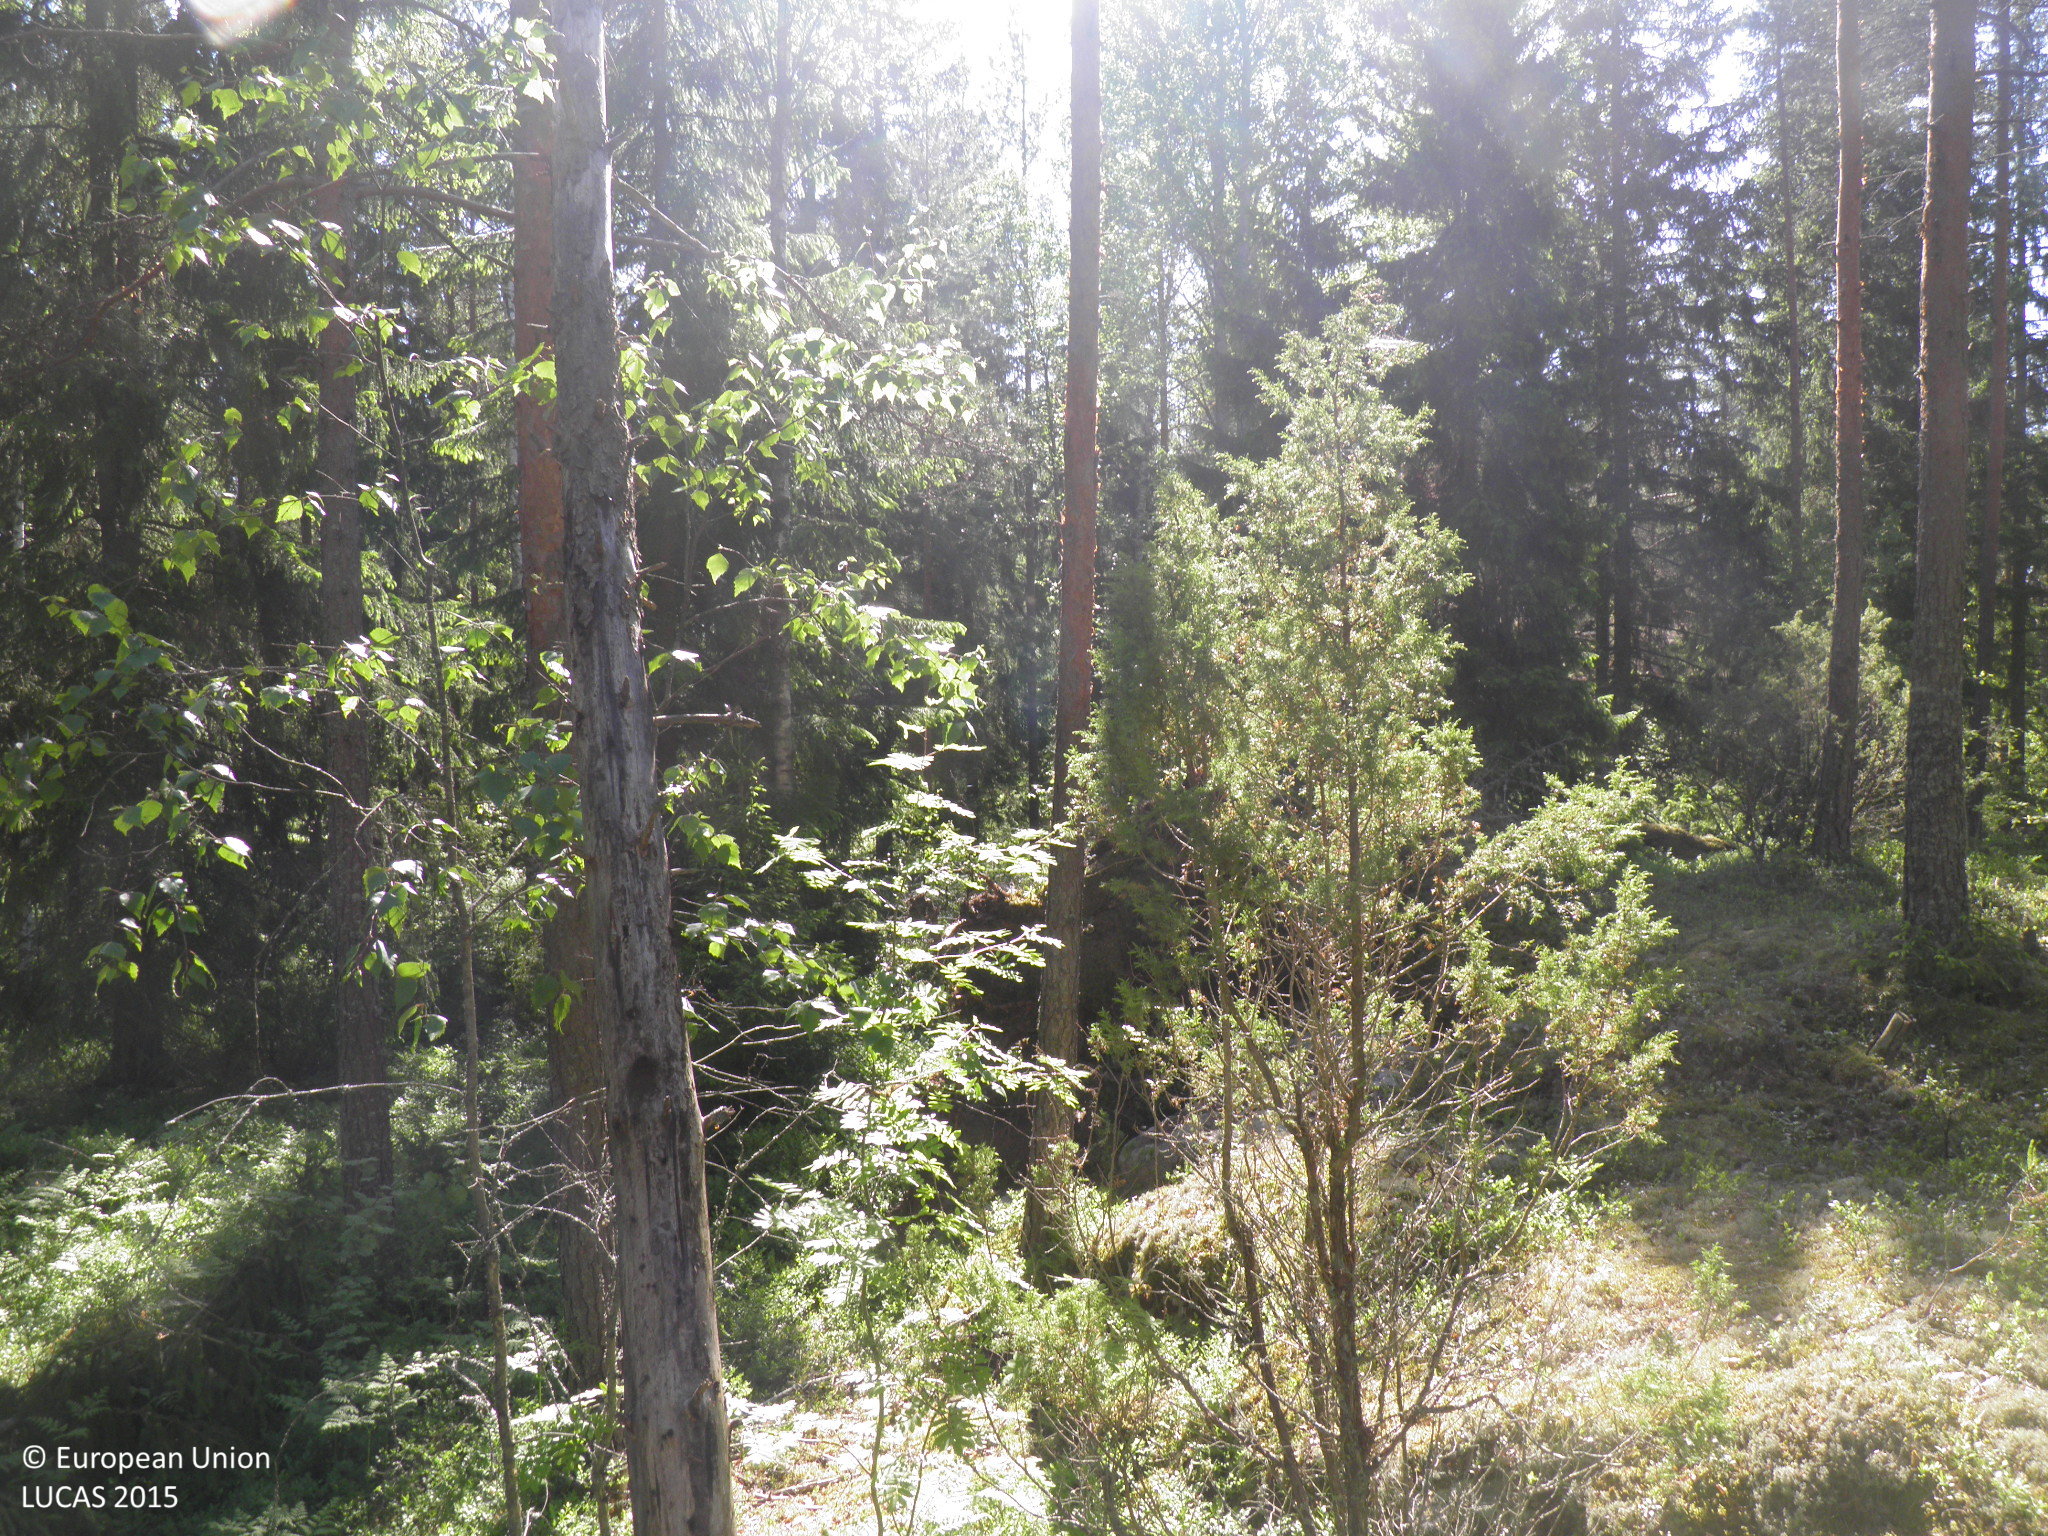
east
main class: Woodland
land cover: Other coniferous woodland
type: hemiboreal forest and nemoral coniferous forest and mixed broadleaved-coniferous forest
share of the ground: 50 - 75 %
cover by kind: coniferous forest trees 60 %, shrubs 15 %, herbaceous plants 15 %, broadleaved forest trees 10 %
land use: Forestry
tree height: > 5 m
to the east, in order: Other coniferous woodland; Other mixed woodland; Ditches and canals; Paved roads, cycling and walking lanes; Grass margins; Ditches and canals; Grass margins; Common wheat
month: June
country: FI
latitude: 60.4148
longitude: 22.6197
